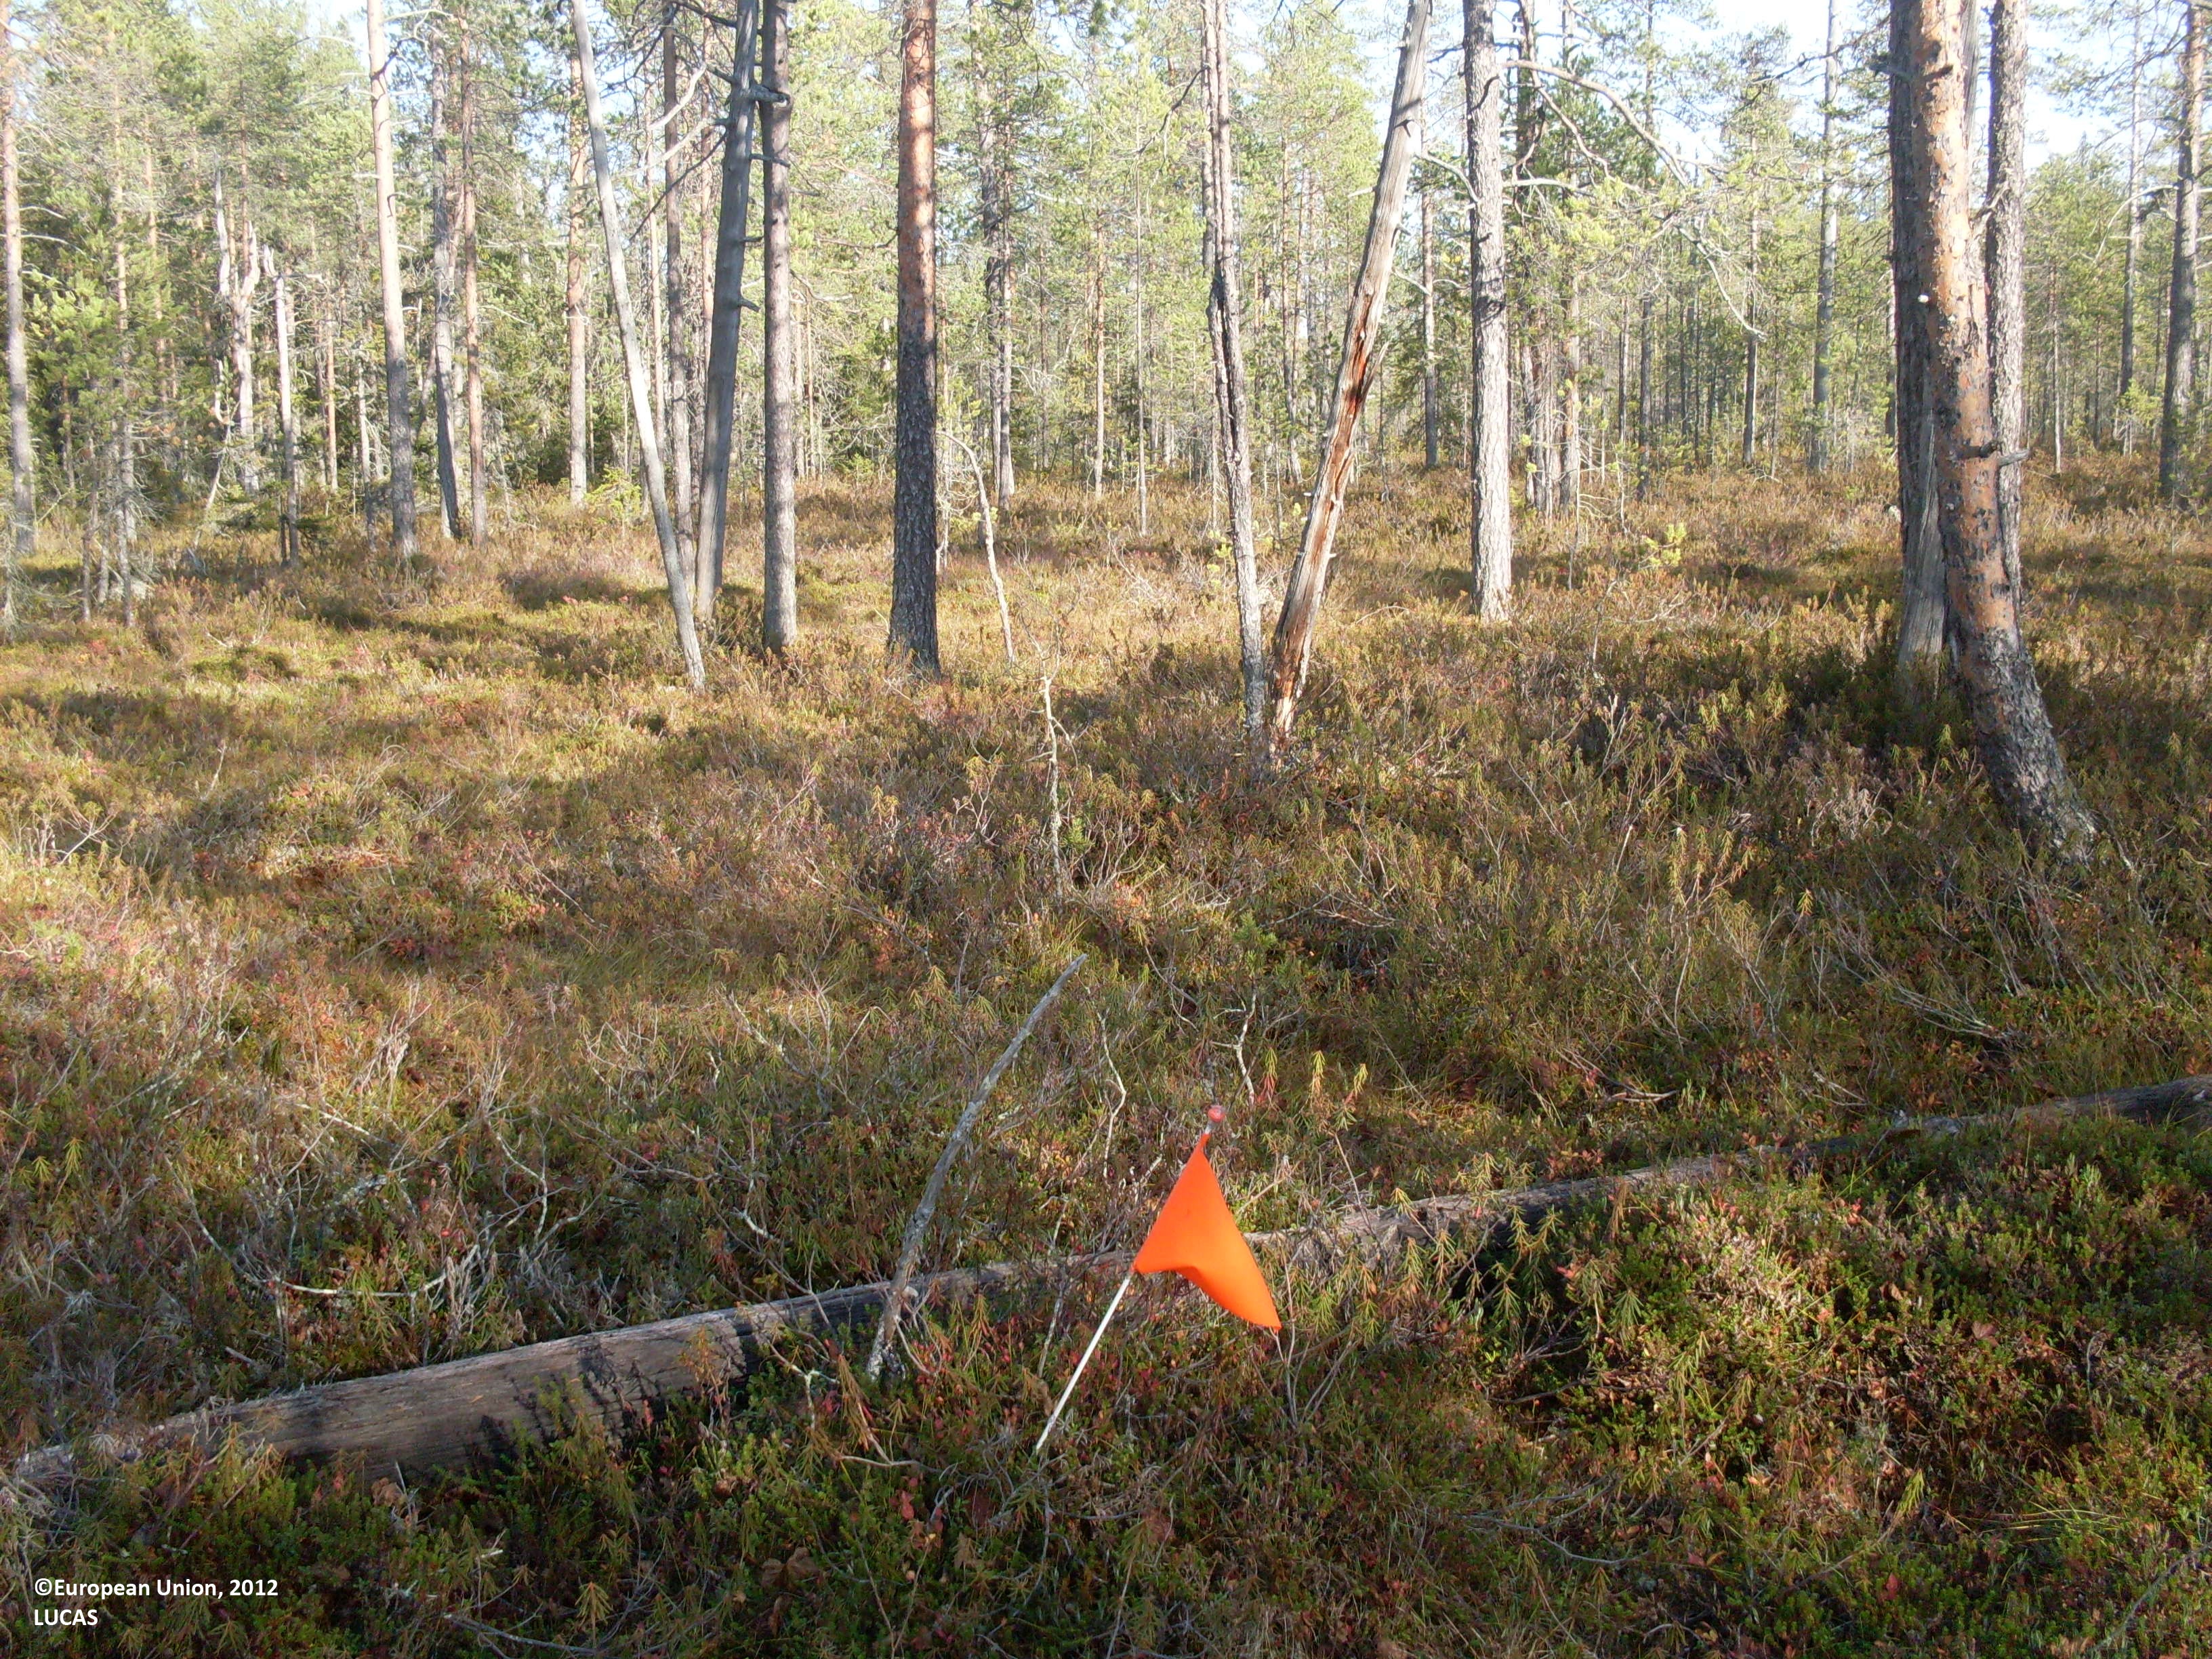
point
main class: Woodland
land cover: Pine dominated coniferous woodland
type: boreal forest
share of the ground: 25 - 50 %
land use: Forestry
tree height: > 5 m
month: September
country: FI
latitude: 64.7728
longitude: 29.7112
